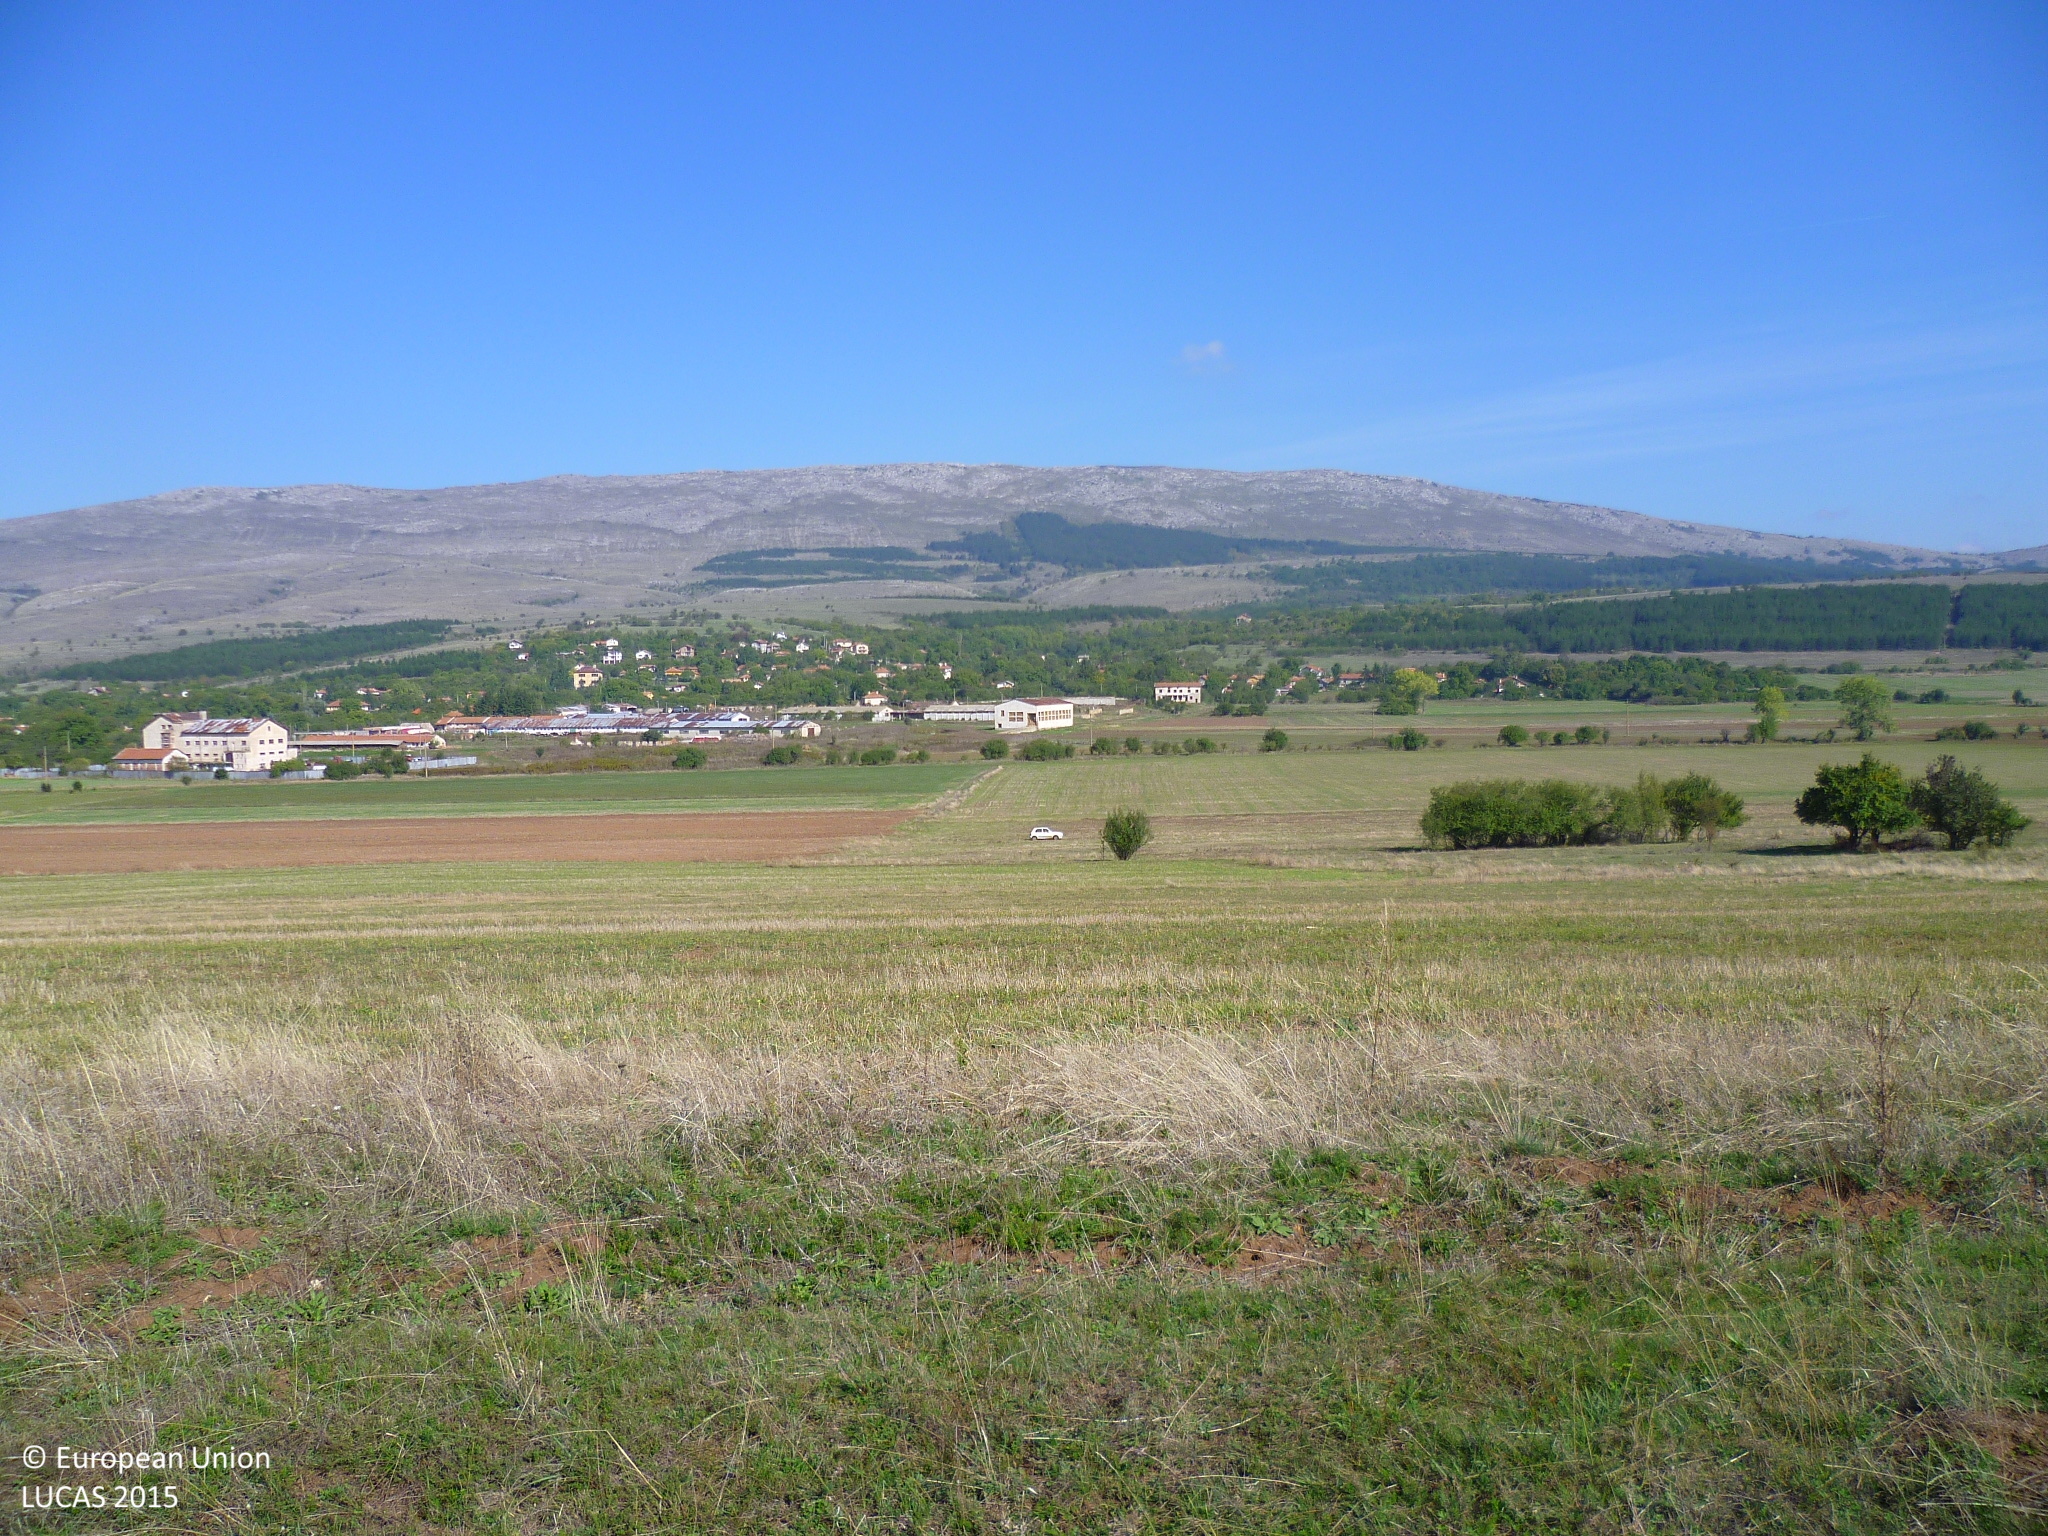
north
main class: Grassland
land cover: Grassland without tree/shrub cover
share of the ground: > 75 %
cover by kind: herbaceous plants 100 %
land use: Agriculture (excluding fallow land and kitchen gardens)
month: October
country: BG
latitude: 42.9256
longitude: 23.0068
